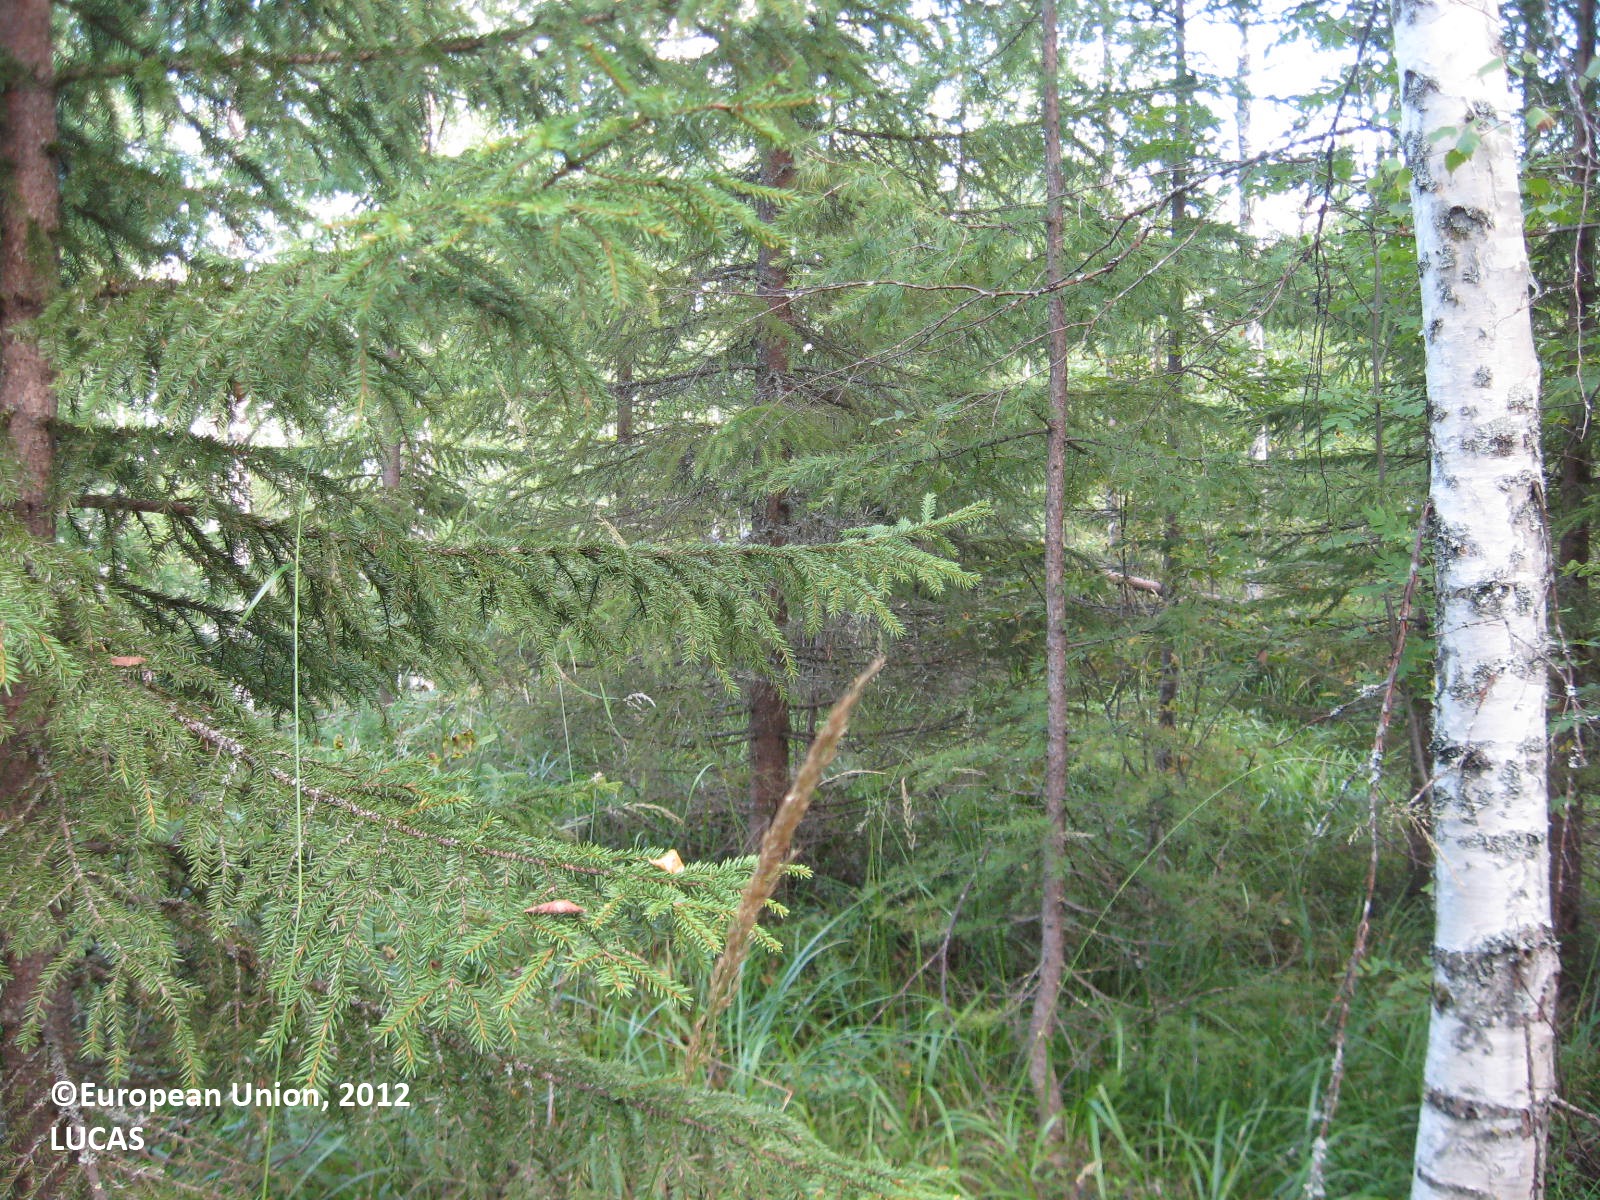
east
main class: Woodland
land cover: Other mixed woodland
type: boreal forest
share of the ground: > 75 %
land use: Forestry
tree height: > 5 m
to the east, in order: Other mixed woodland
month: August
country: FI
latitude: 63.5959
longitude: 29.8095
